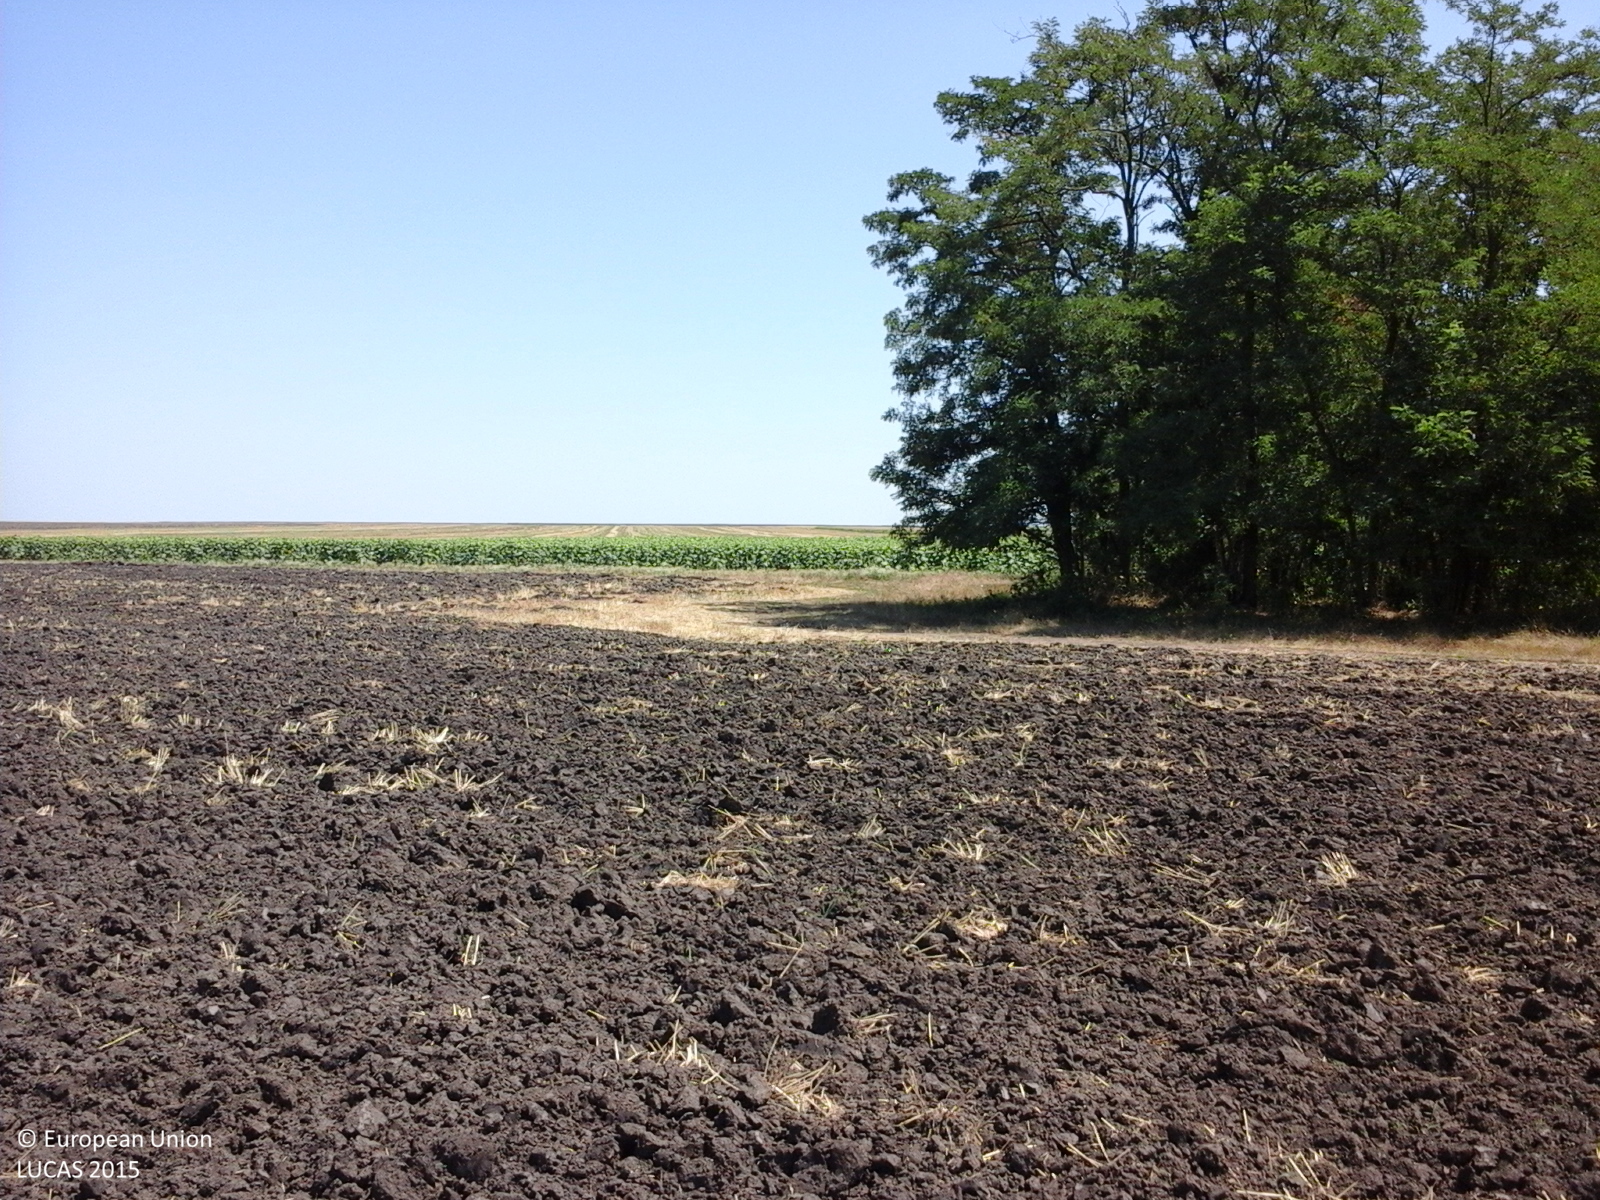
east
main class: Cropland
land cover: Common wheat
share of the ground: < 10 %
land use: Agriculture (excluding fallow land and kitchen gardens)
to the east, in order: Common wheat; Tracks; Common wheat; Tracks; Grass margins; Sunflower; Tracks; Grass margins; Common wheat
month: July
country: RO
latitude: 44.2817
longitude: 26.6446
